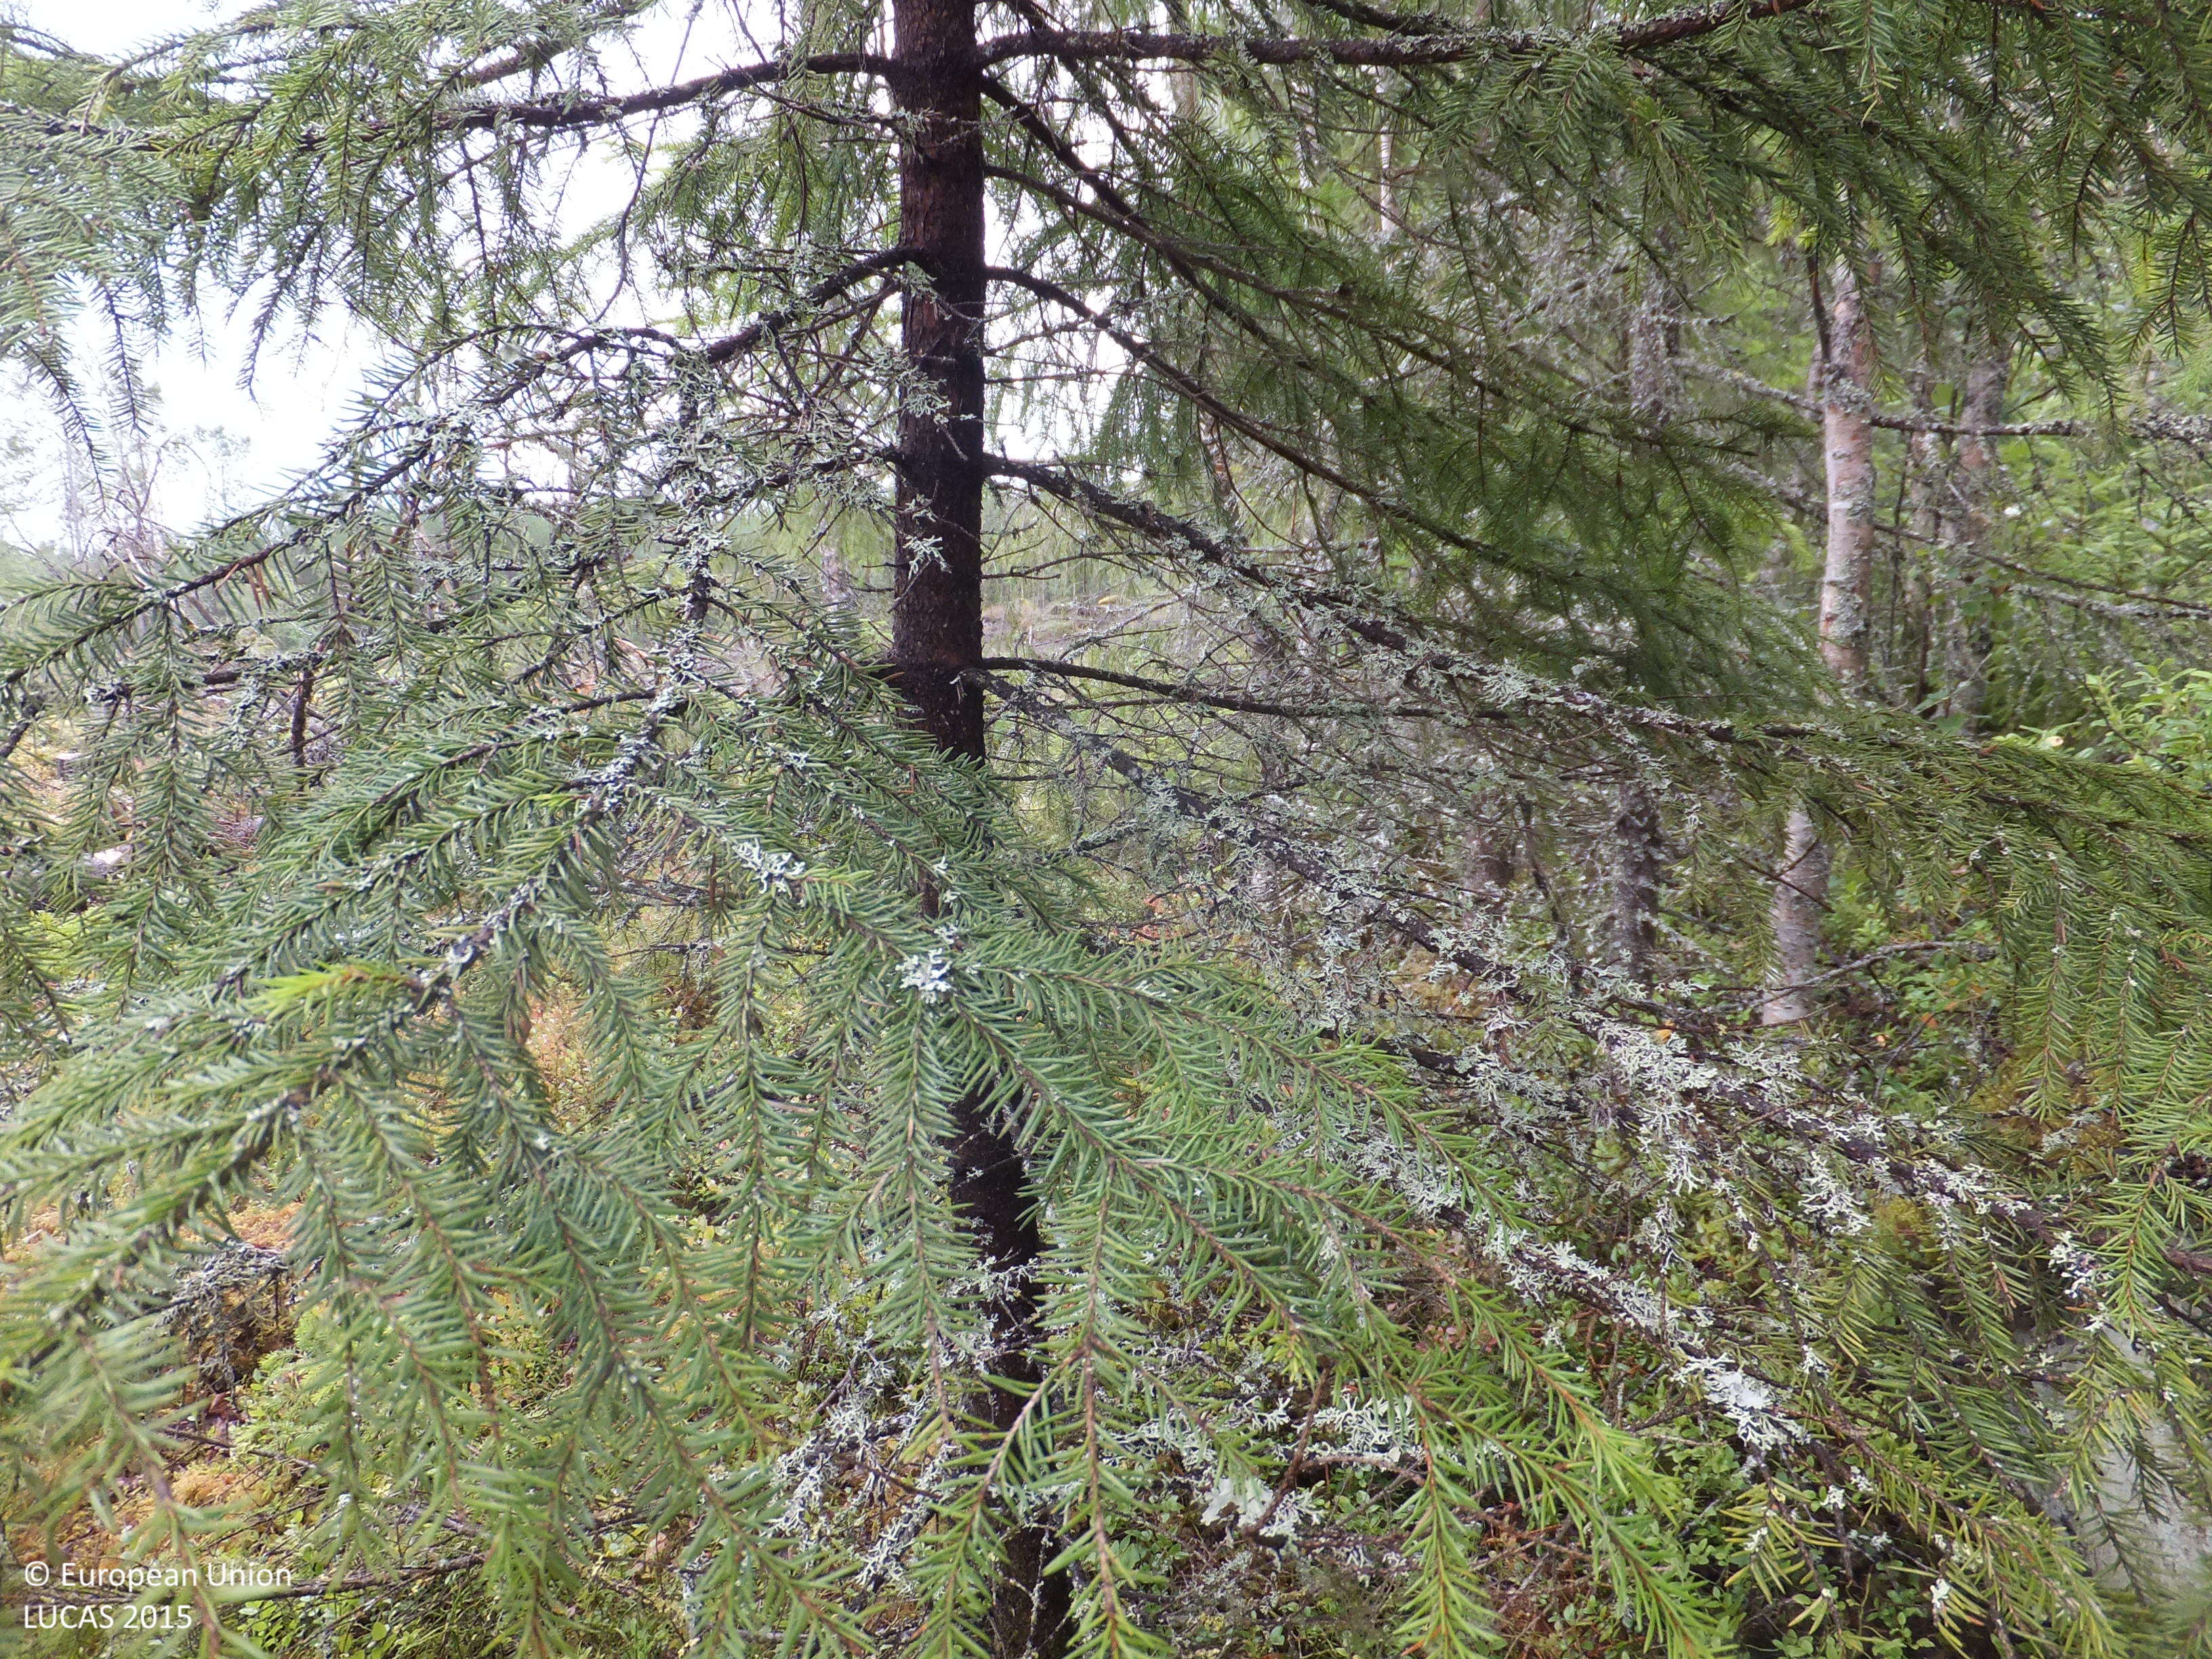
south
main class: Woodland
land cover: Other mixed woodland
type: boreal forest
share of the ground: 50 - 75 %
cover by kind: coniferous forest trees 30 %, broadleaved forest trees 30 %, shrubs 20 %, lichens and mosses 10 %, consolidated bare surface 10 %
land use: Forestry
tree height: > 5 m
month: July
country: FI
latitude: 63.2426
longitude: 21.8072
